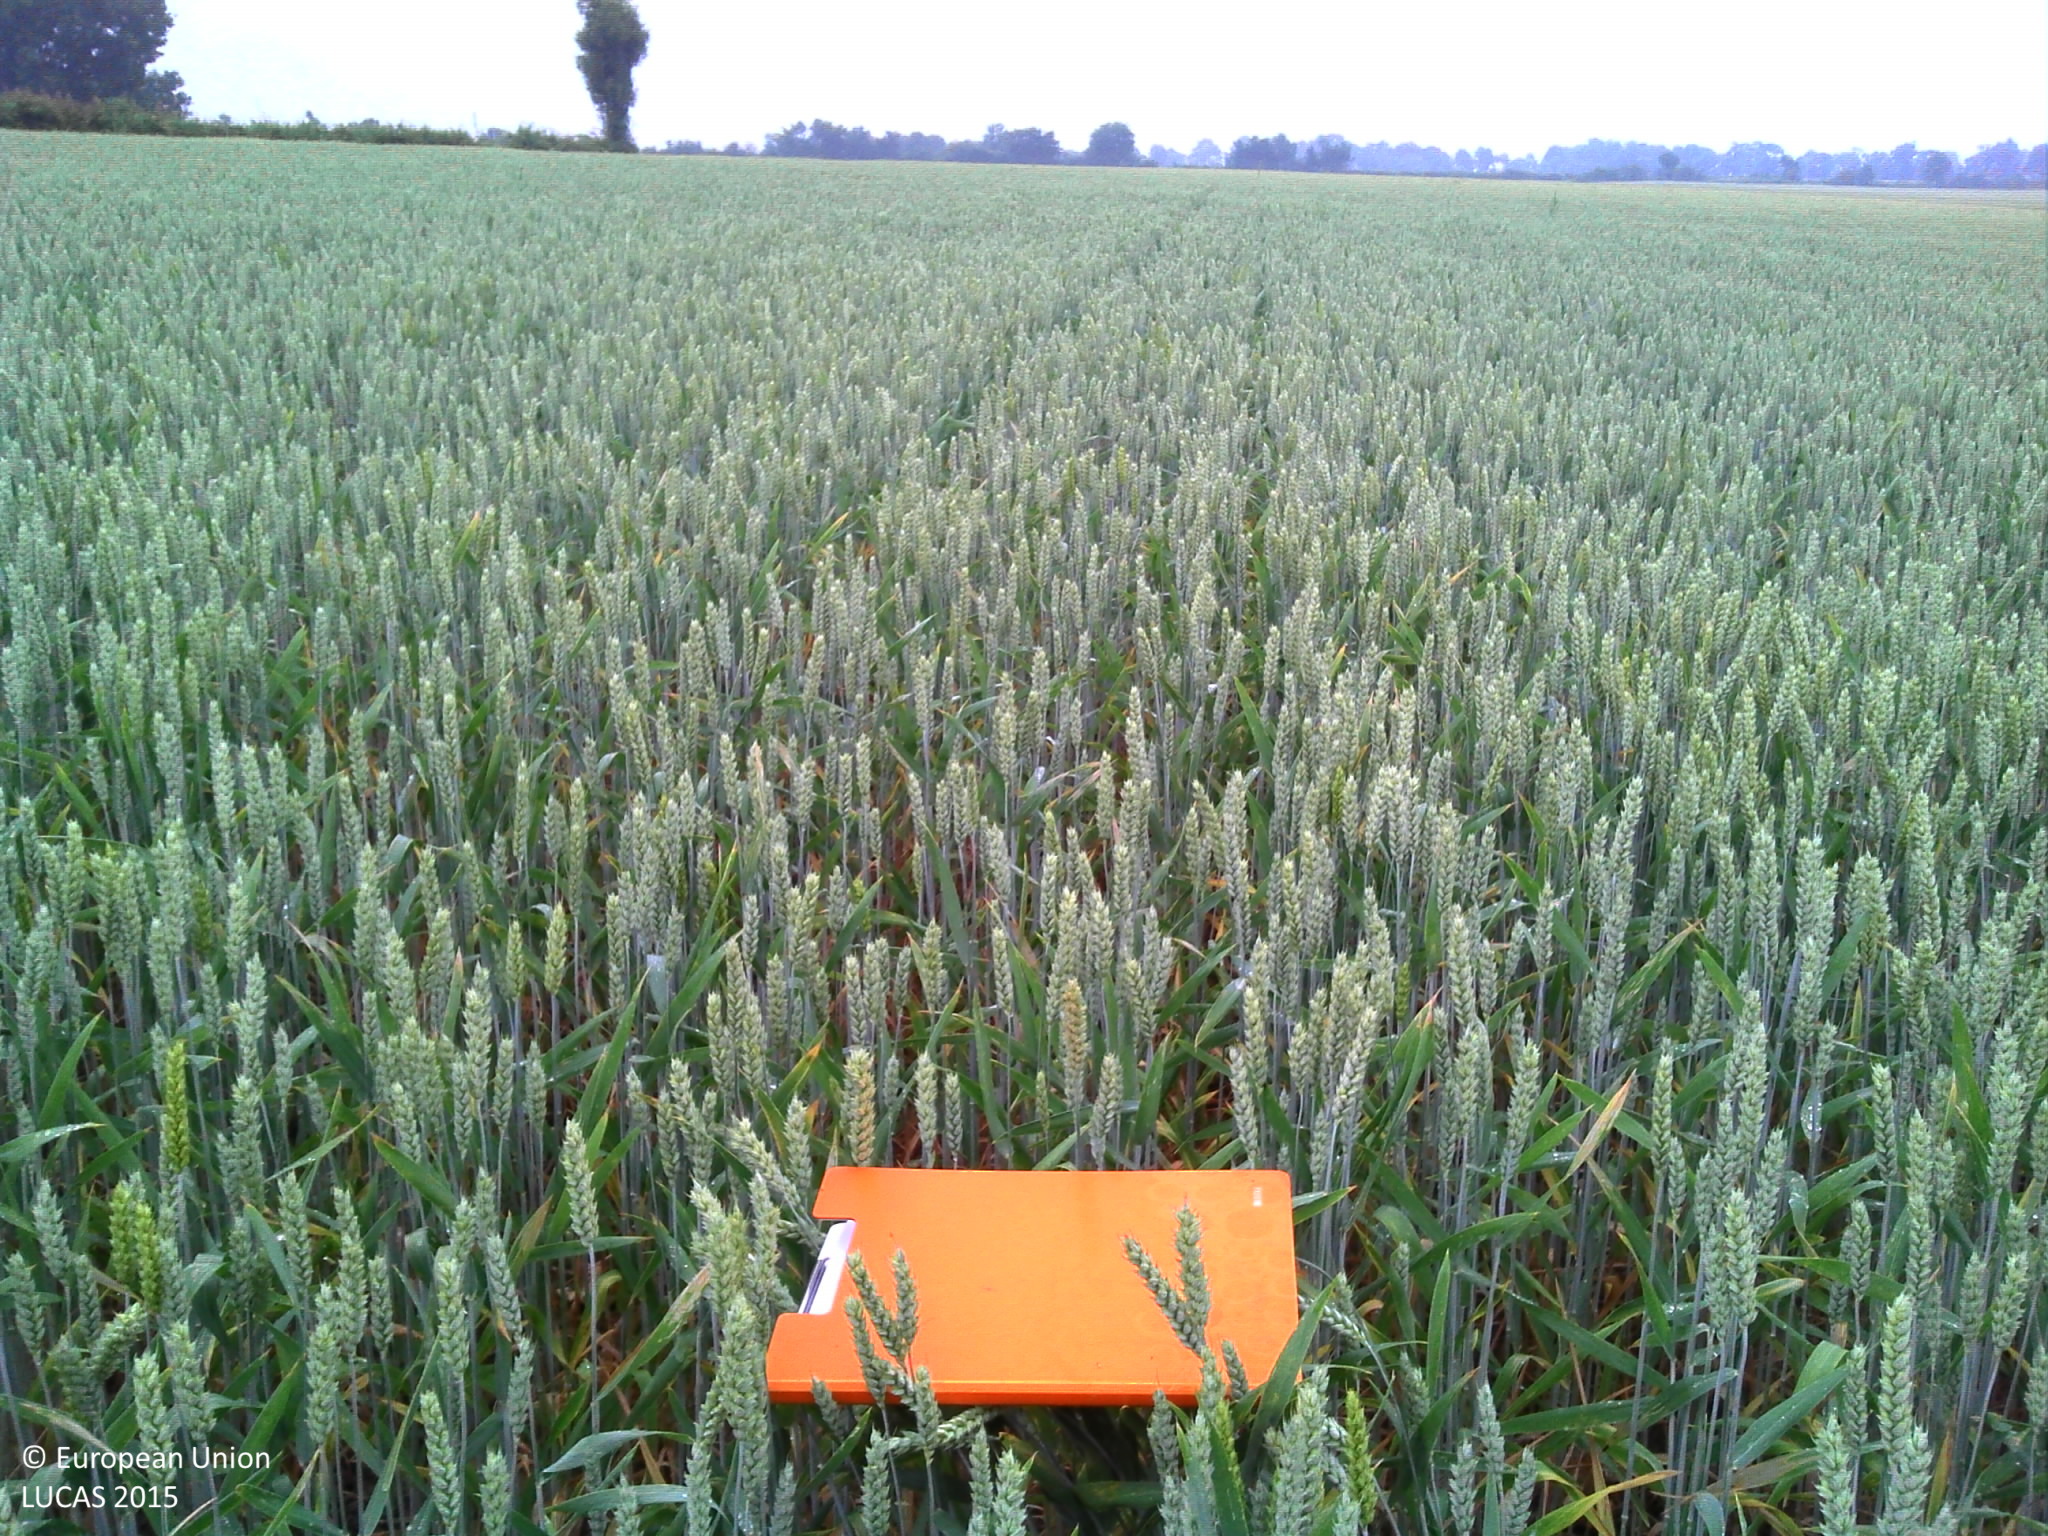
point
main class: Cropland
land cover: Common wheat
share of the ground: > 75 %
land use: Agriculture (excluding fallow land and kitchen gardens)
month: June
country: FR
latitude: 47.5207
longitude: 2.5685
